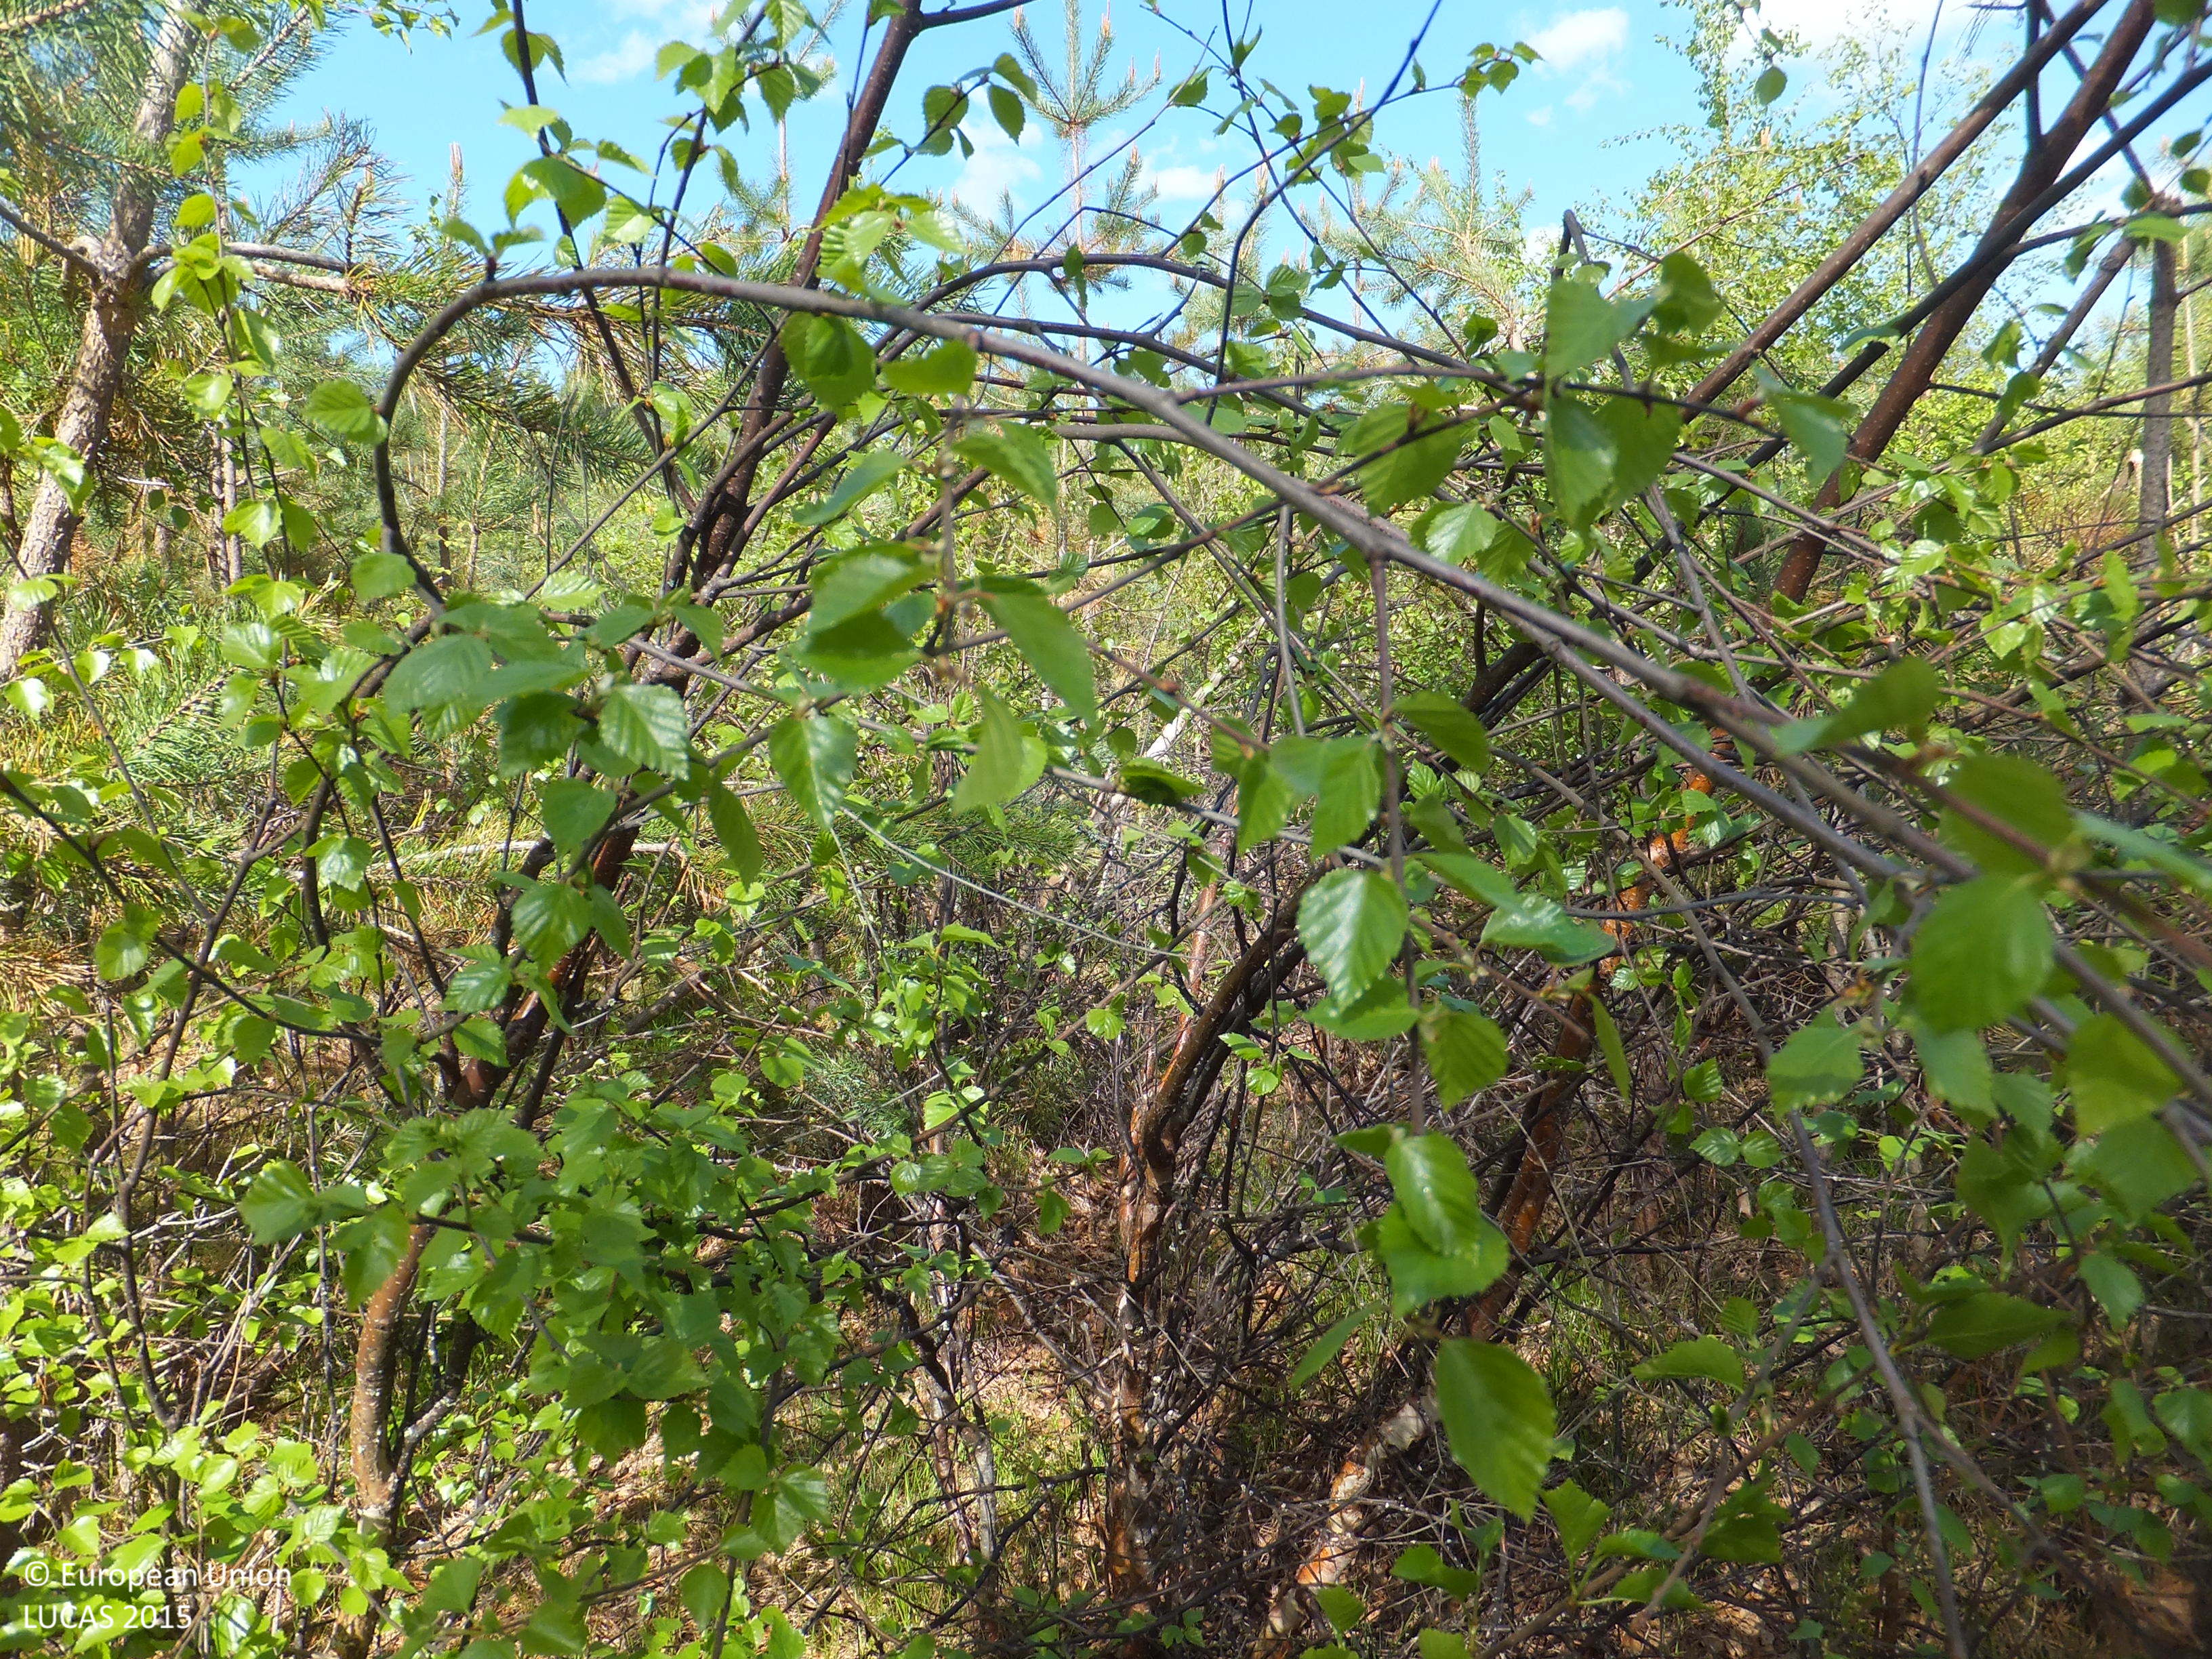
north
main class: Woodland
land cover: Pine dominated mixed woodland
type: boreal forest
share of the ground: > 75 %
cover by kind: broadleaved forest trees 70 %, coniferous forest trees 30 %
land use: Forestry
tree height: < 5 m
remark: Clear cut
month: June
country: FI
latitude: 63.4854
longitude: 22.8822
